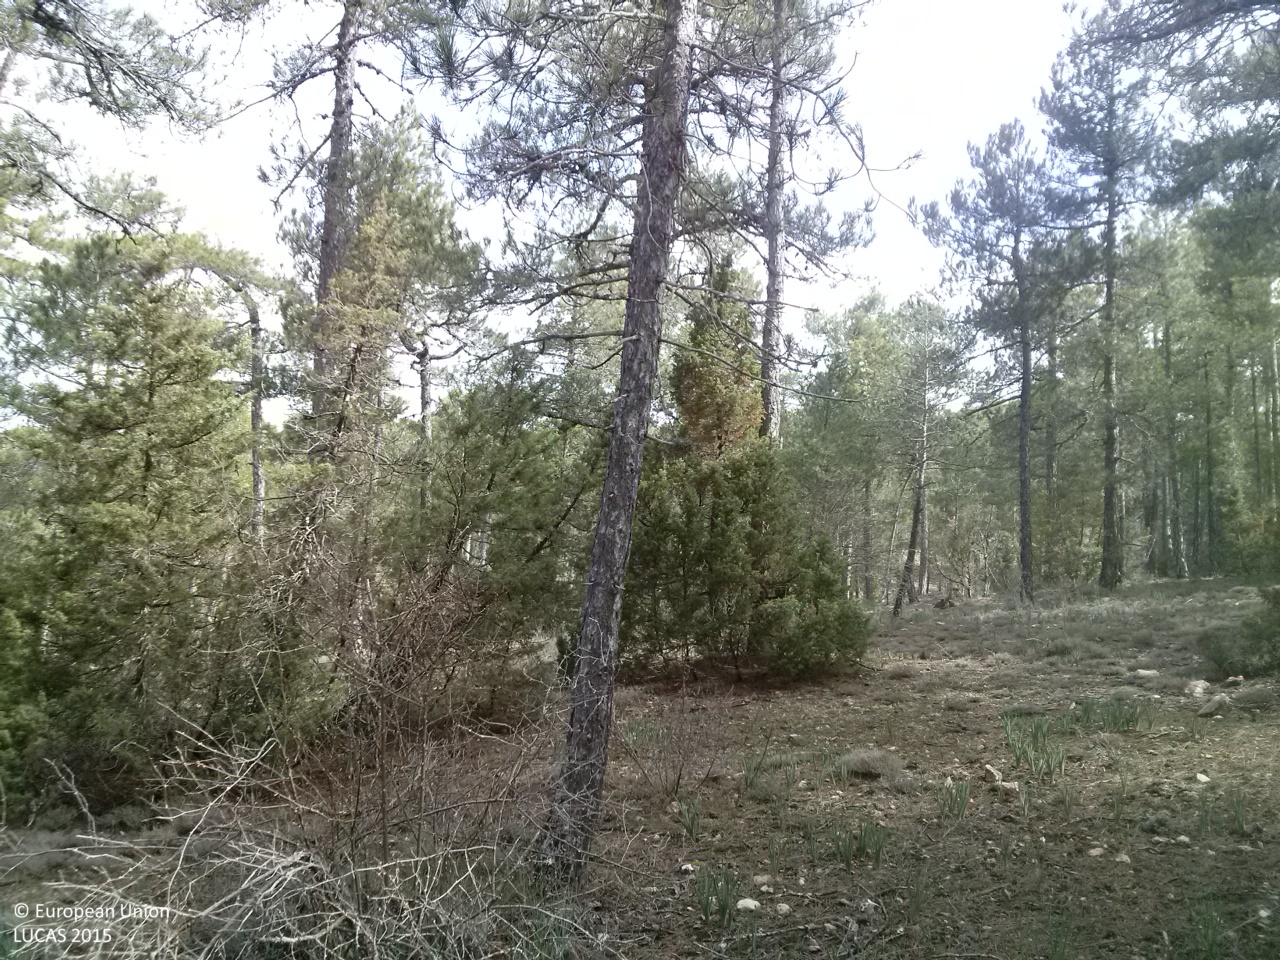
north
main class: Woodland
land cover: Pine dominated coniferous woodland
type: coniferous forest of the mediterranean region
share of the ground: 50 - 75 %
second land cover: Grassland without tree/shrub cover
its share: 10 - 25 %
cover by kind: coniferous forest trees 70 %, herbaceous plants 25 %, consolidated bare surface 5 %
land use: Forestry
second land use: Agriculture (excluding fallow land and kitchen gardens)
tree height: > 5 m
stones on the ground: 10 - 25 %
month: April
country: ES
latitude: 40.2525
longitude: -1.9018
